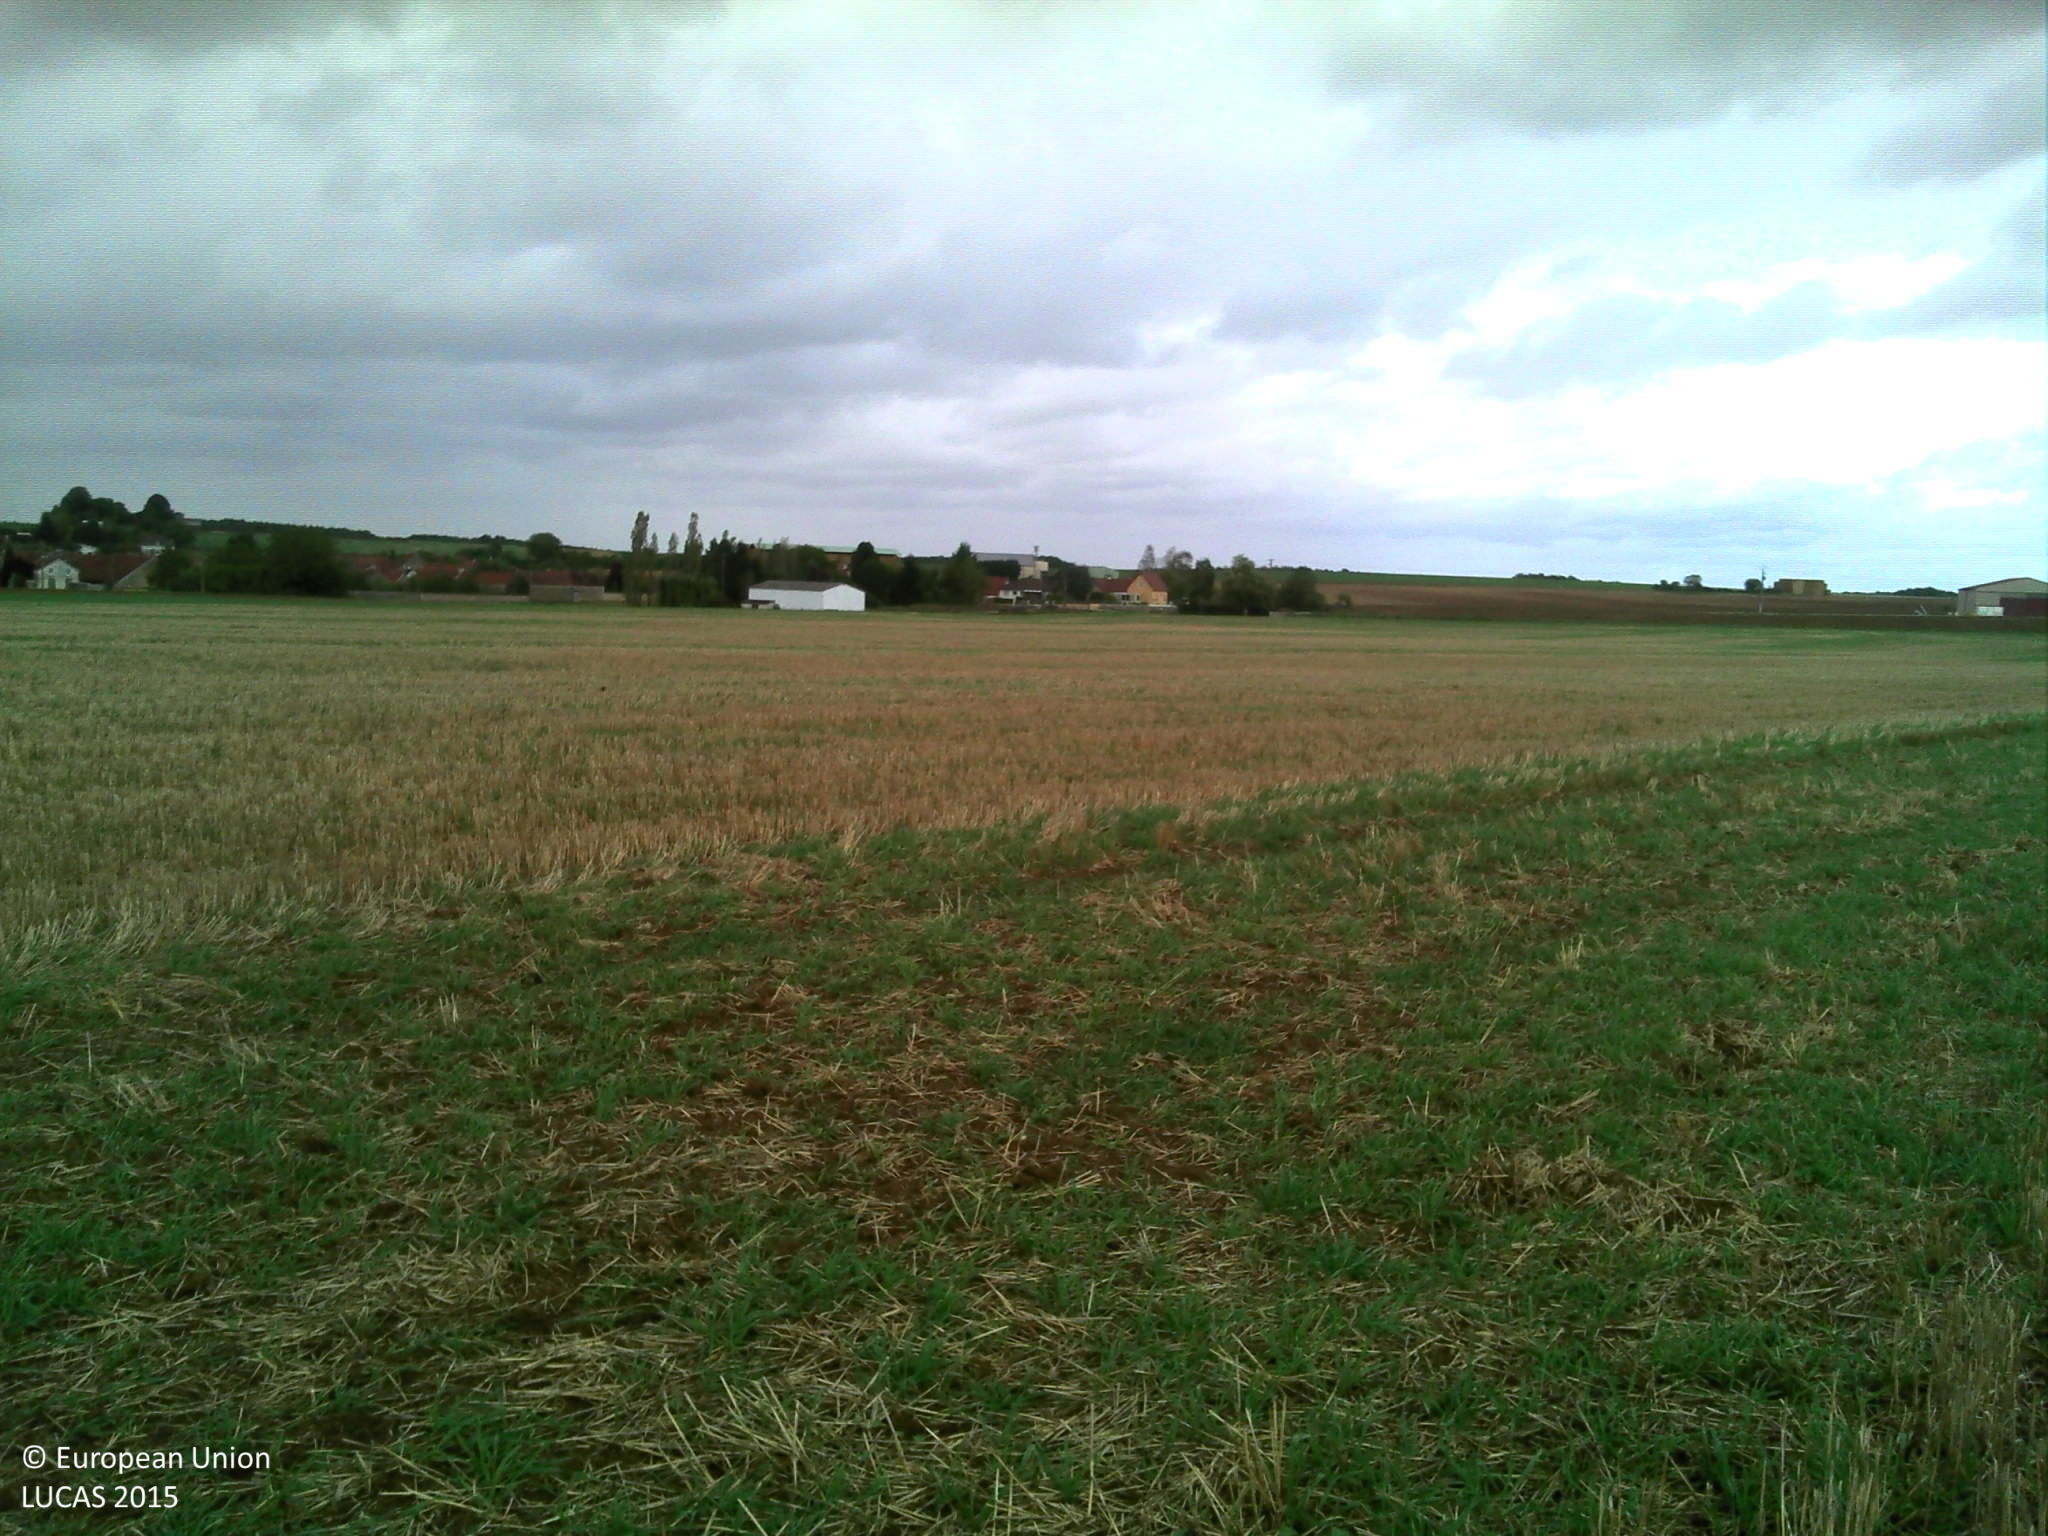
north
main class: Cropland
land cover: Common wheat
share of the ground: 25 - 50 %
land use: Agriculture (excluding fallow land and kitchen gardens)
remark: Harvested field
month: September
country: FR
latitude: 47.7142
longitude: 4.2798
